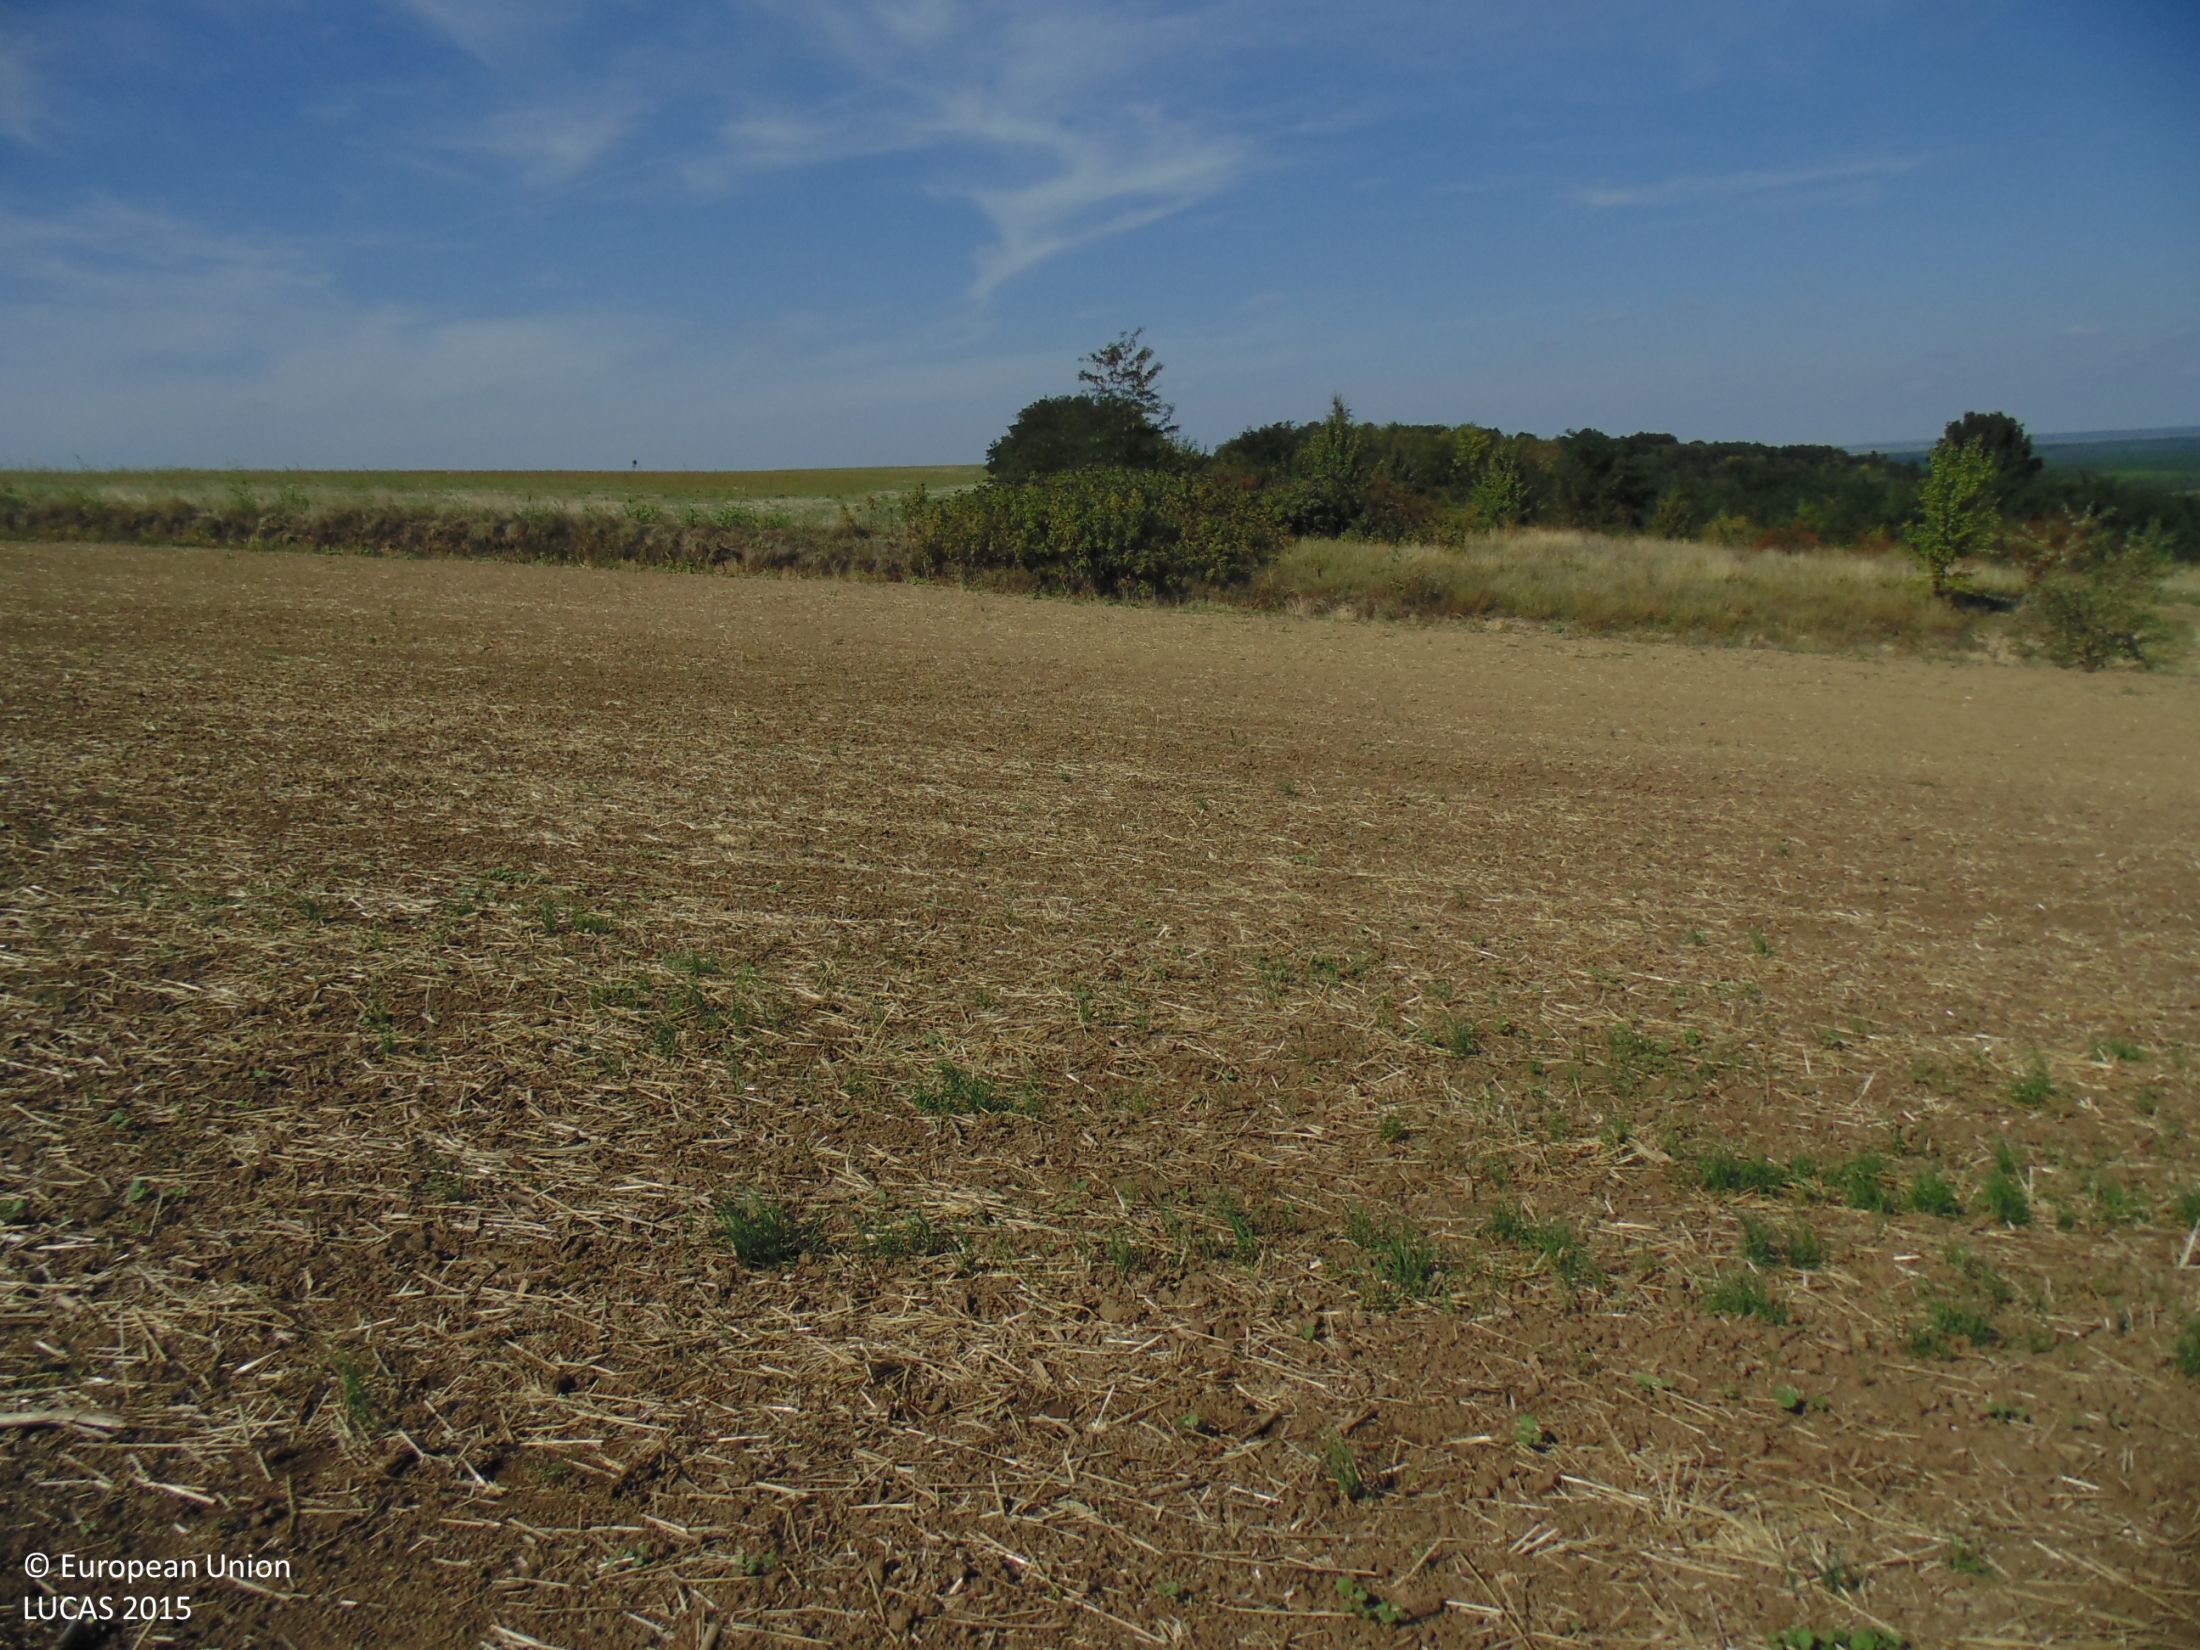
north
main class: Cropland
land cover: Common wheat
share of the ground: < 10 %
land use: Agriculture (excluding fallow land and kitchen gardens)
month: September
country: BG
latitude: 44.0933
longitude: 26.8963
